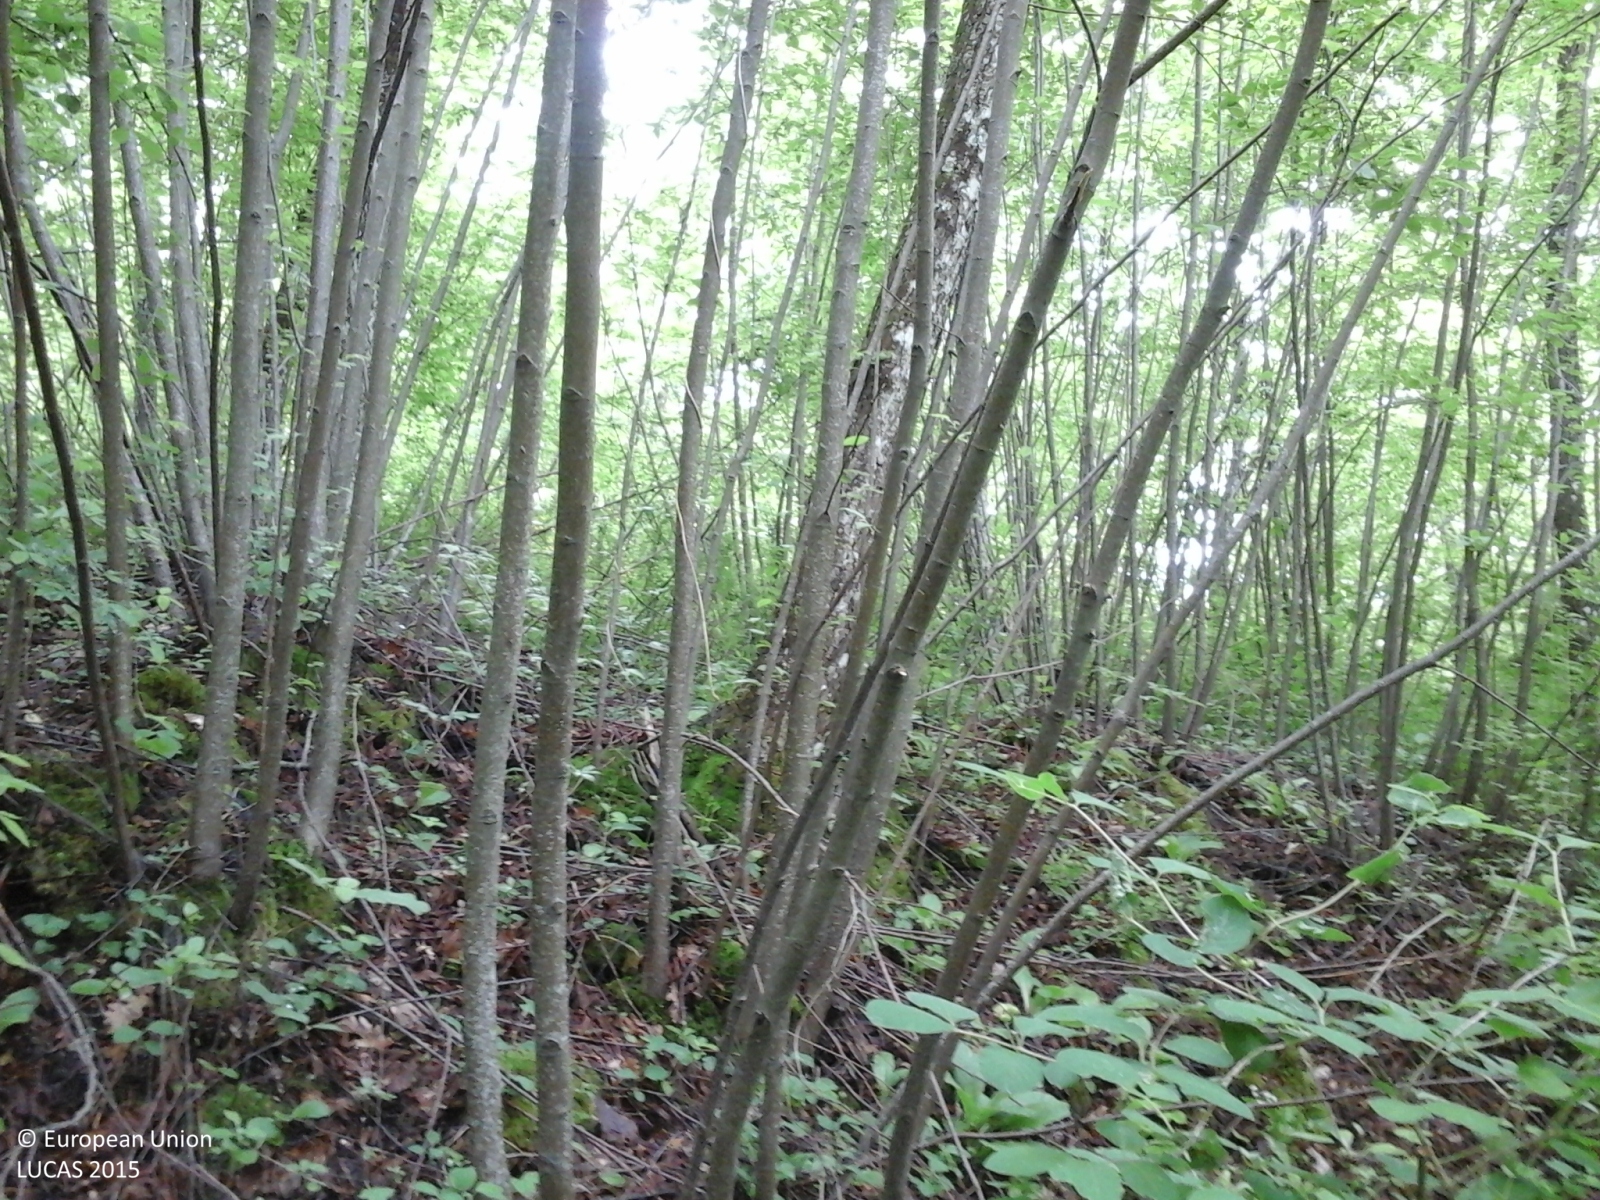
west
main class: Woodland
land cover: Broadleaved woodland
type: thermophilous deciduous forest
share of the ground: > 75 %
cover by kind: broadleaved forest trees 80 %, shrubs 20 %
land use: Forestry
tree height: > 5 m
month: May
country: IT
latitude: 44.5849
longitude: 10.1634
